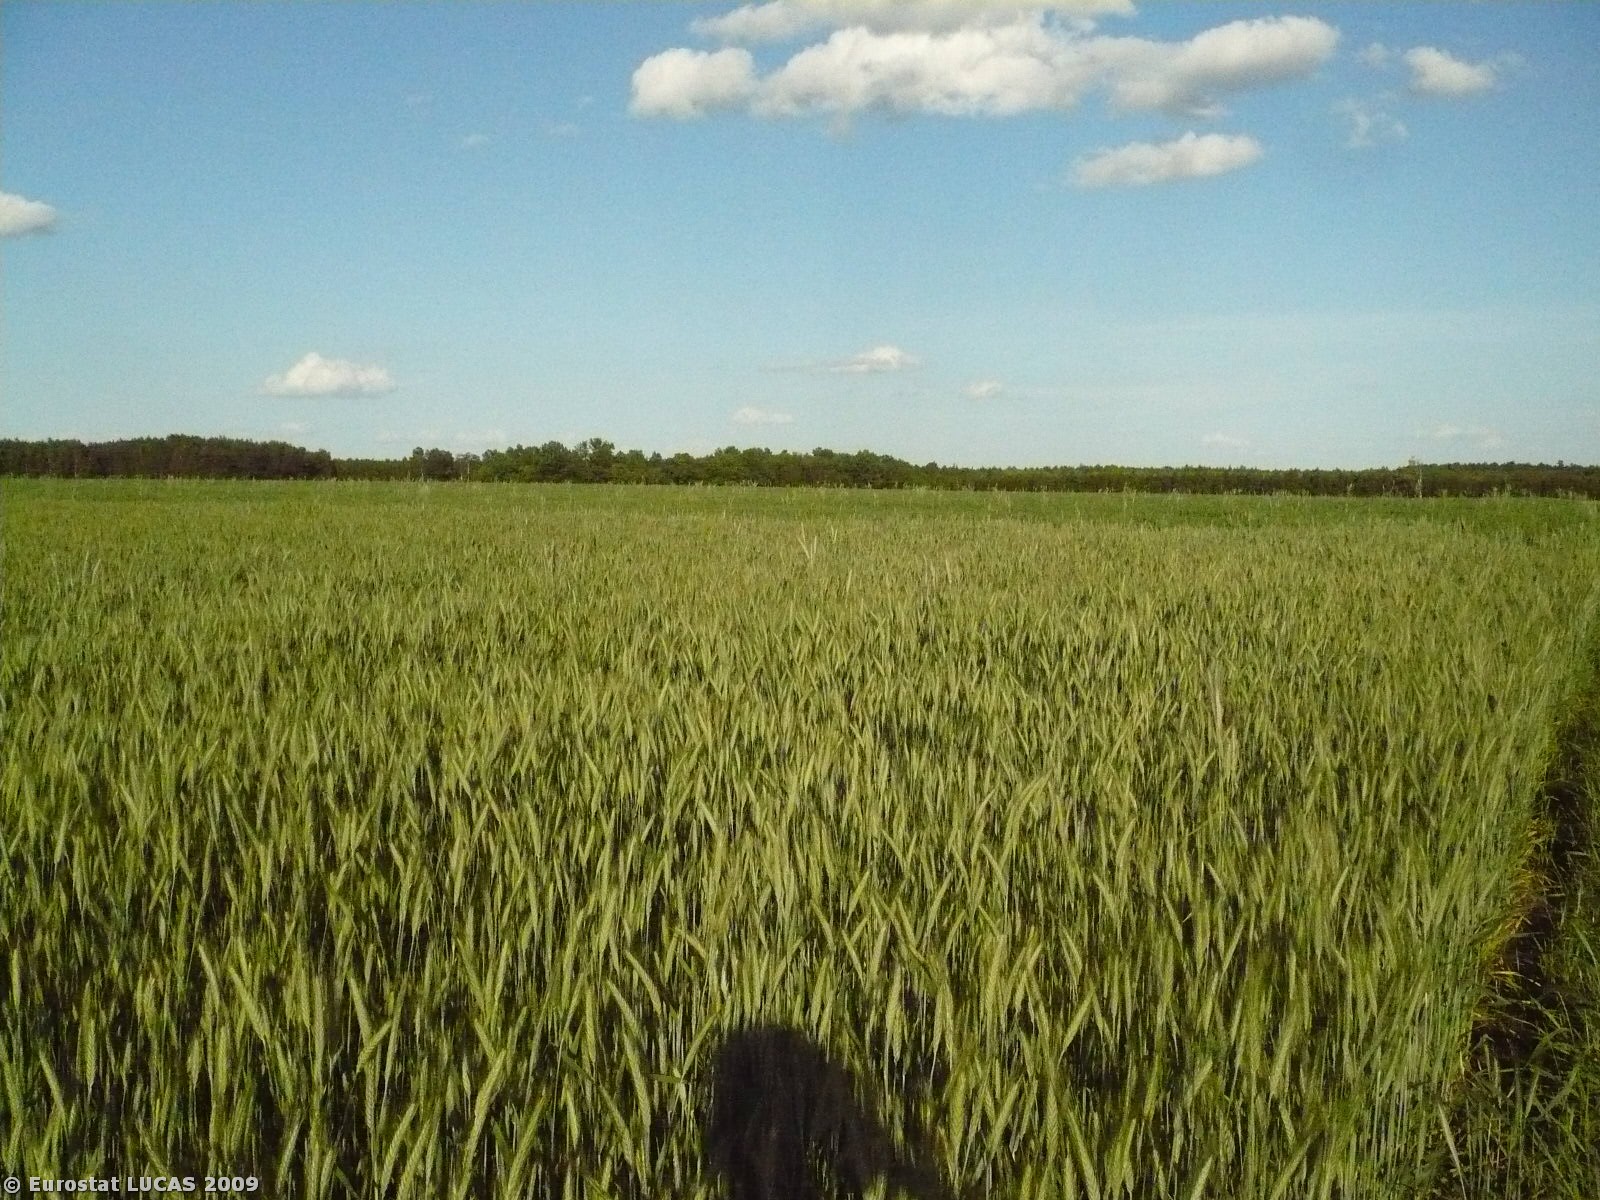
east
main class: Cropland
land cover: Triticale
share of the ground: > 75 %
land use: Agriculture (excluding fallow land and kitchen gardens)
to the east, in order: Triticale; Durum wheat; Common wheat; Rye; Common wheat; Rape and turnip rape
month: May
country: PL
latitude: 52.1378
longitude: 16.3041
